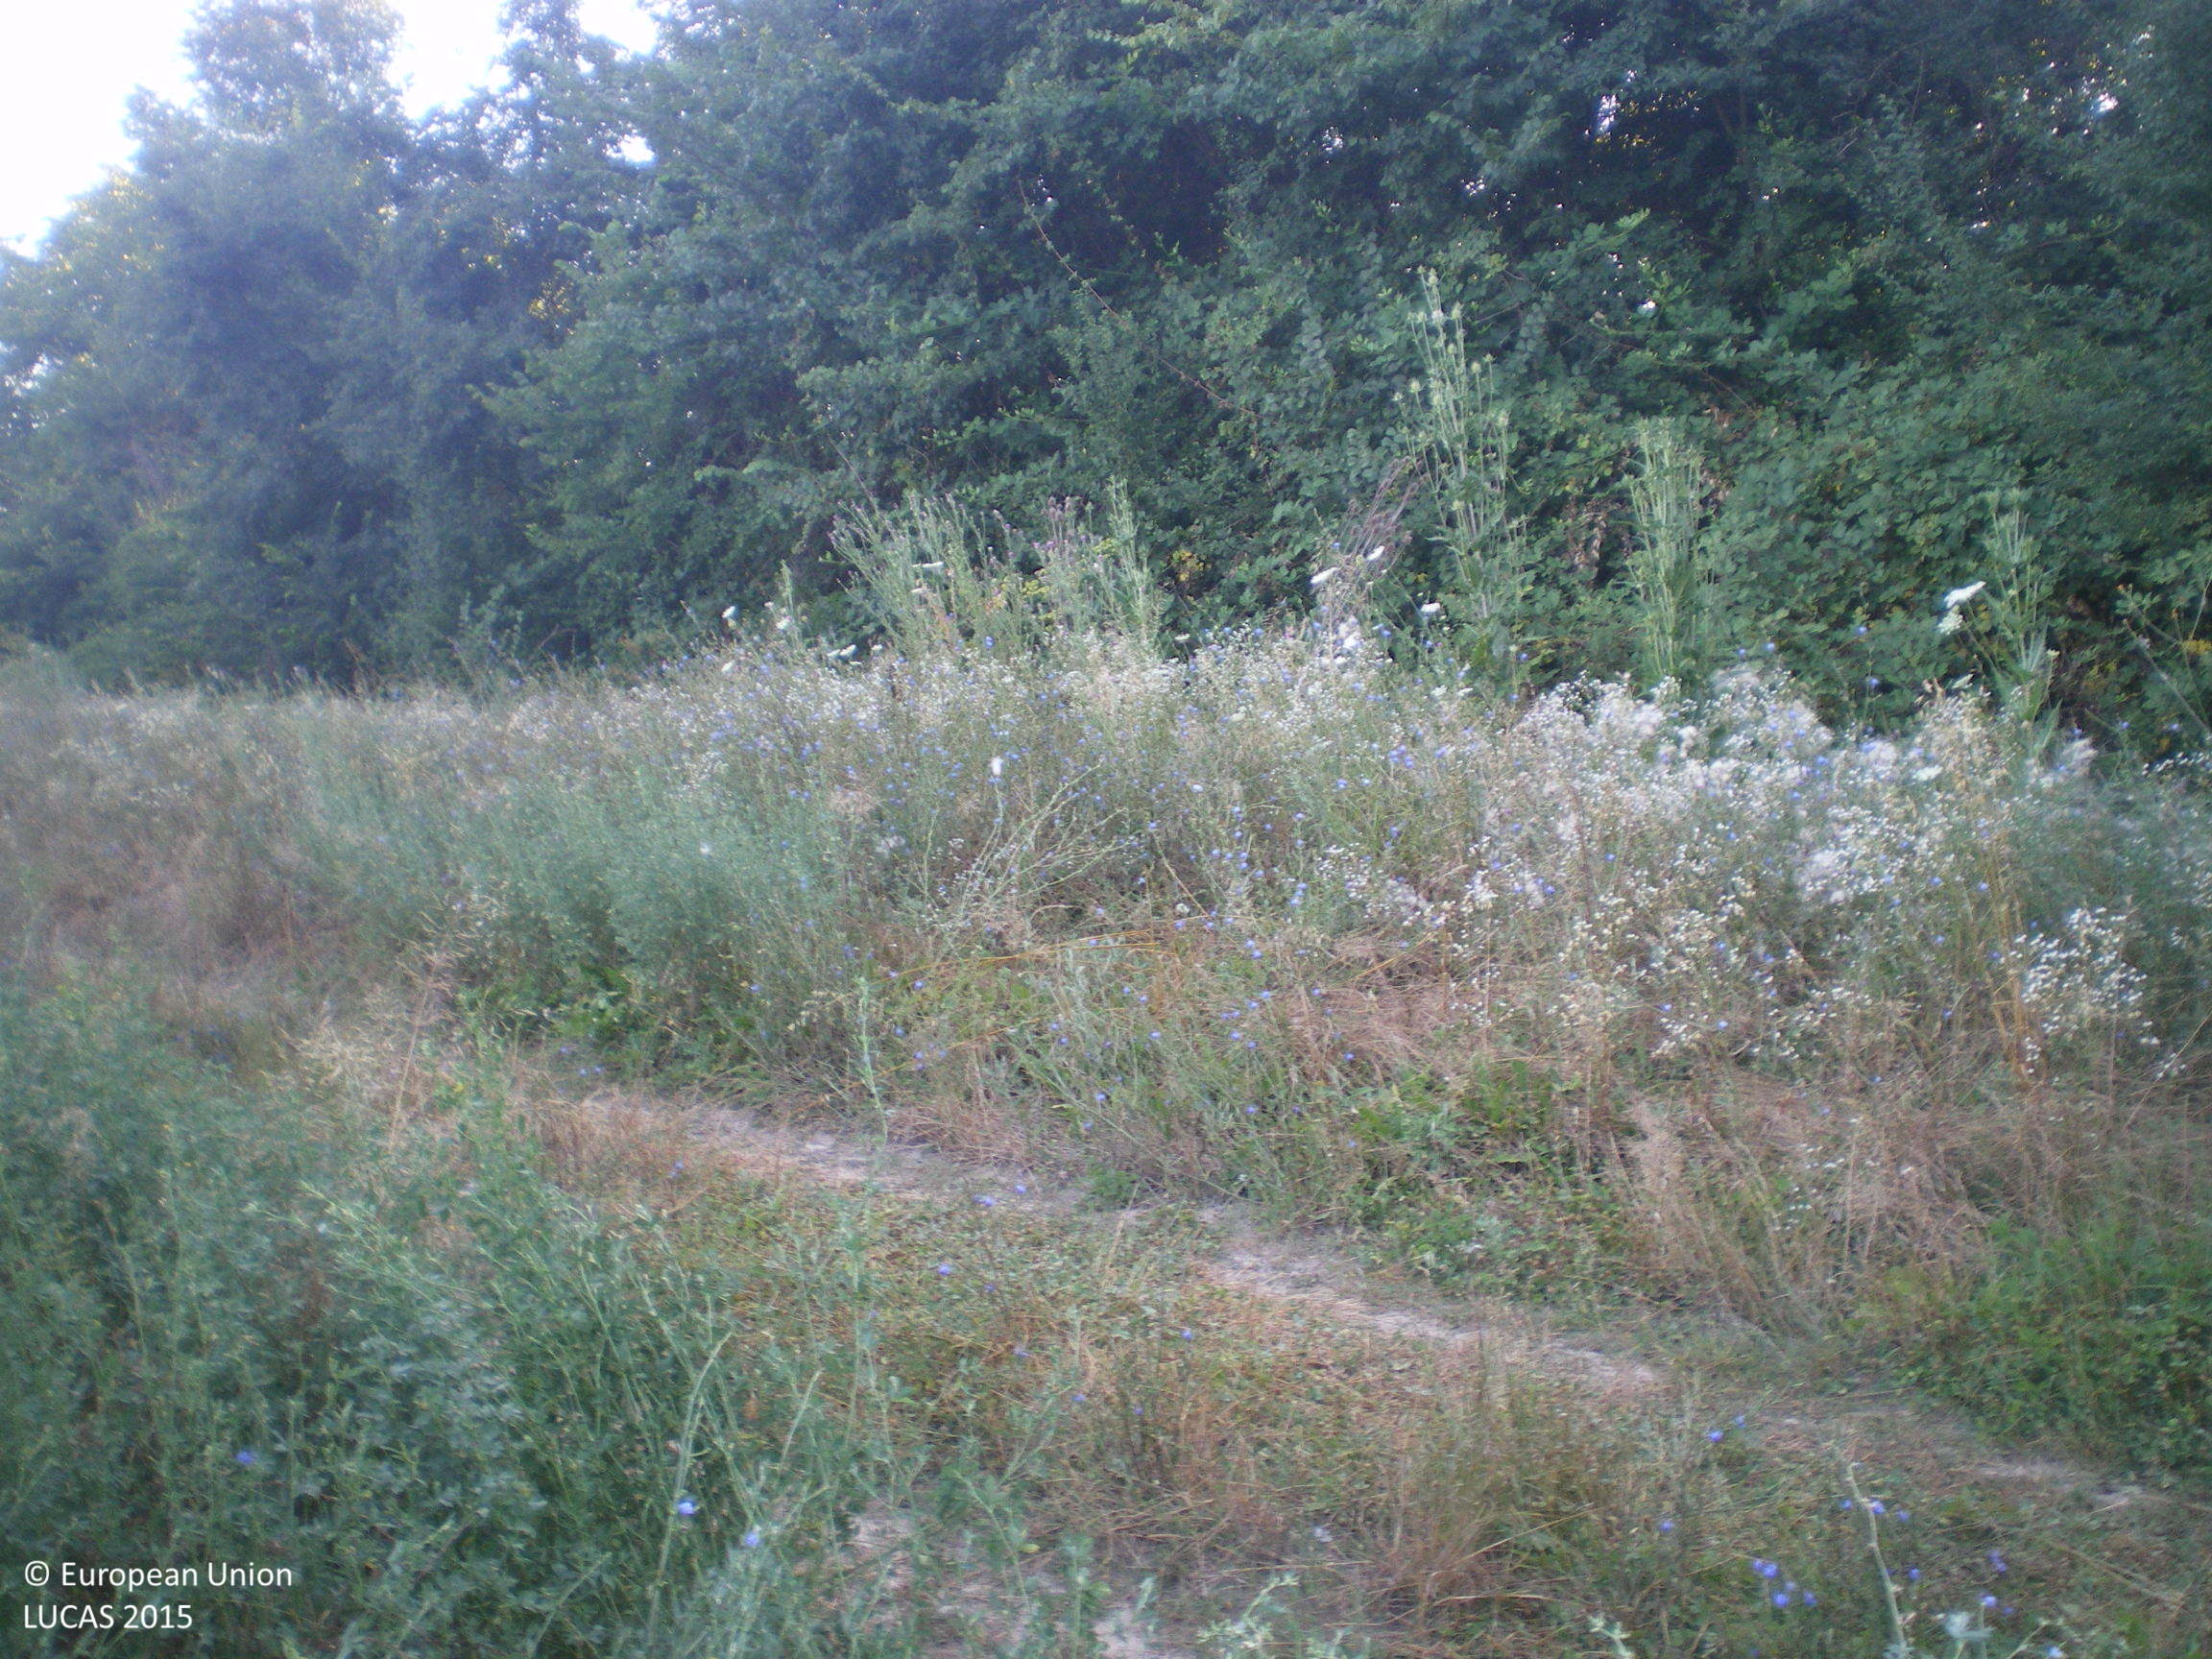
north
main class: Grassland
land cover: Spontaneously vegetated surfaces
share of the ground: > 75 %
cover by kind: herbaceous plants 100 %
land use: Agriculture (excluding fallow land and kitchen gardens)
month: July
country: BG
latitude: 42.6291
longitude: 25.2476
